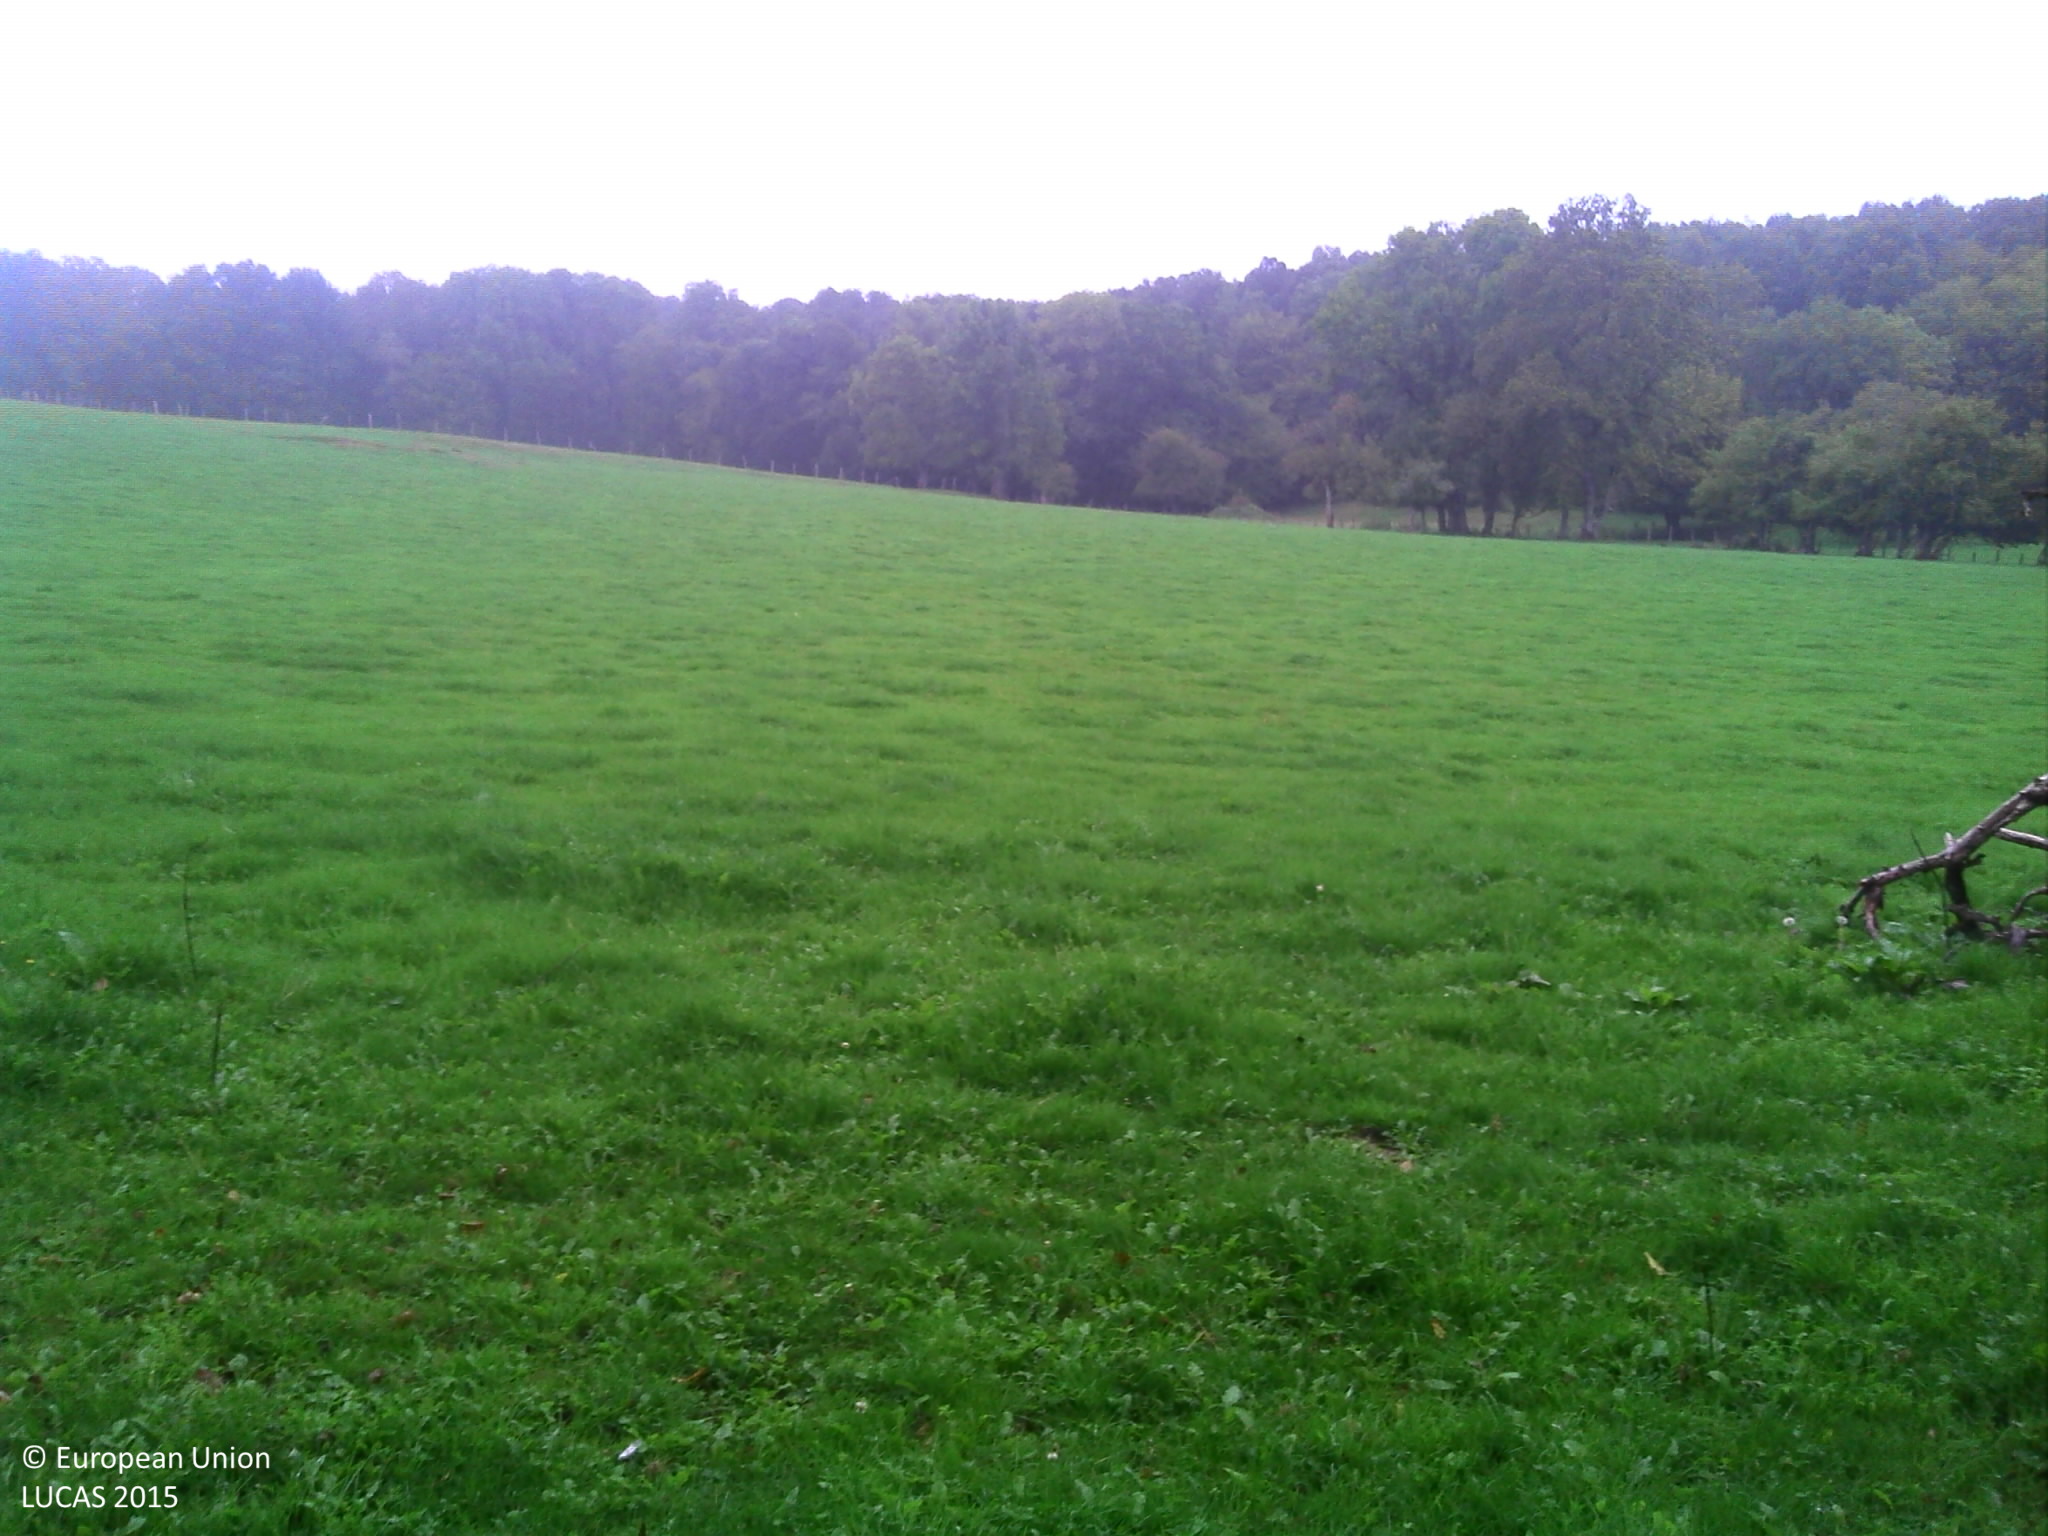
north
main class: Grassland
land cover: Grassland with sparse tree/shrub cover
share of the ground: > 75 %
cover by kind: herbaceous plants 95 %, broadleaved forest trees 5 %
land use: Agriculture (excluding fallow land and kitchen gardens)
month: September
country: FR
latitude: 48.5962
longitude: 0.7705
